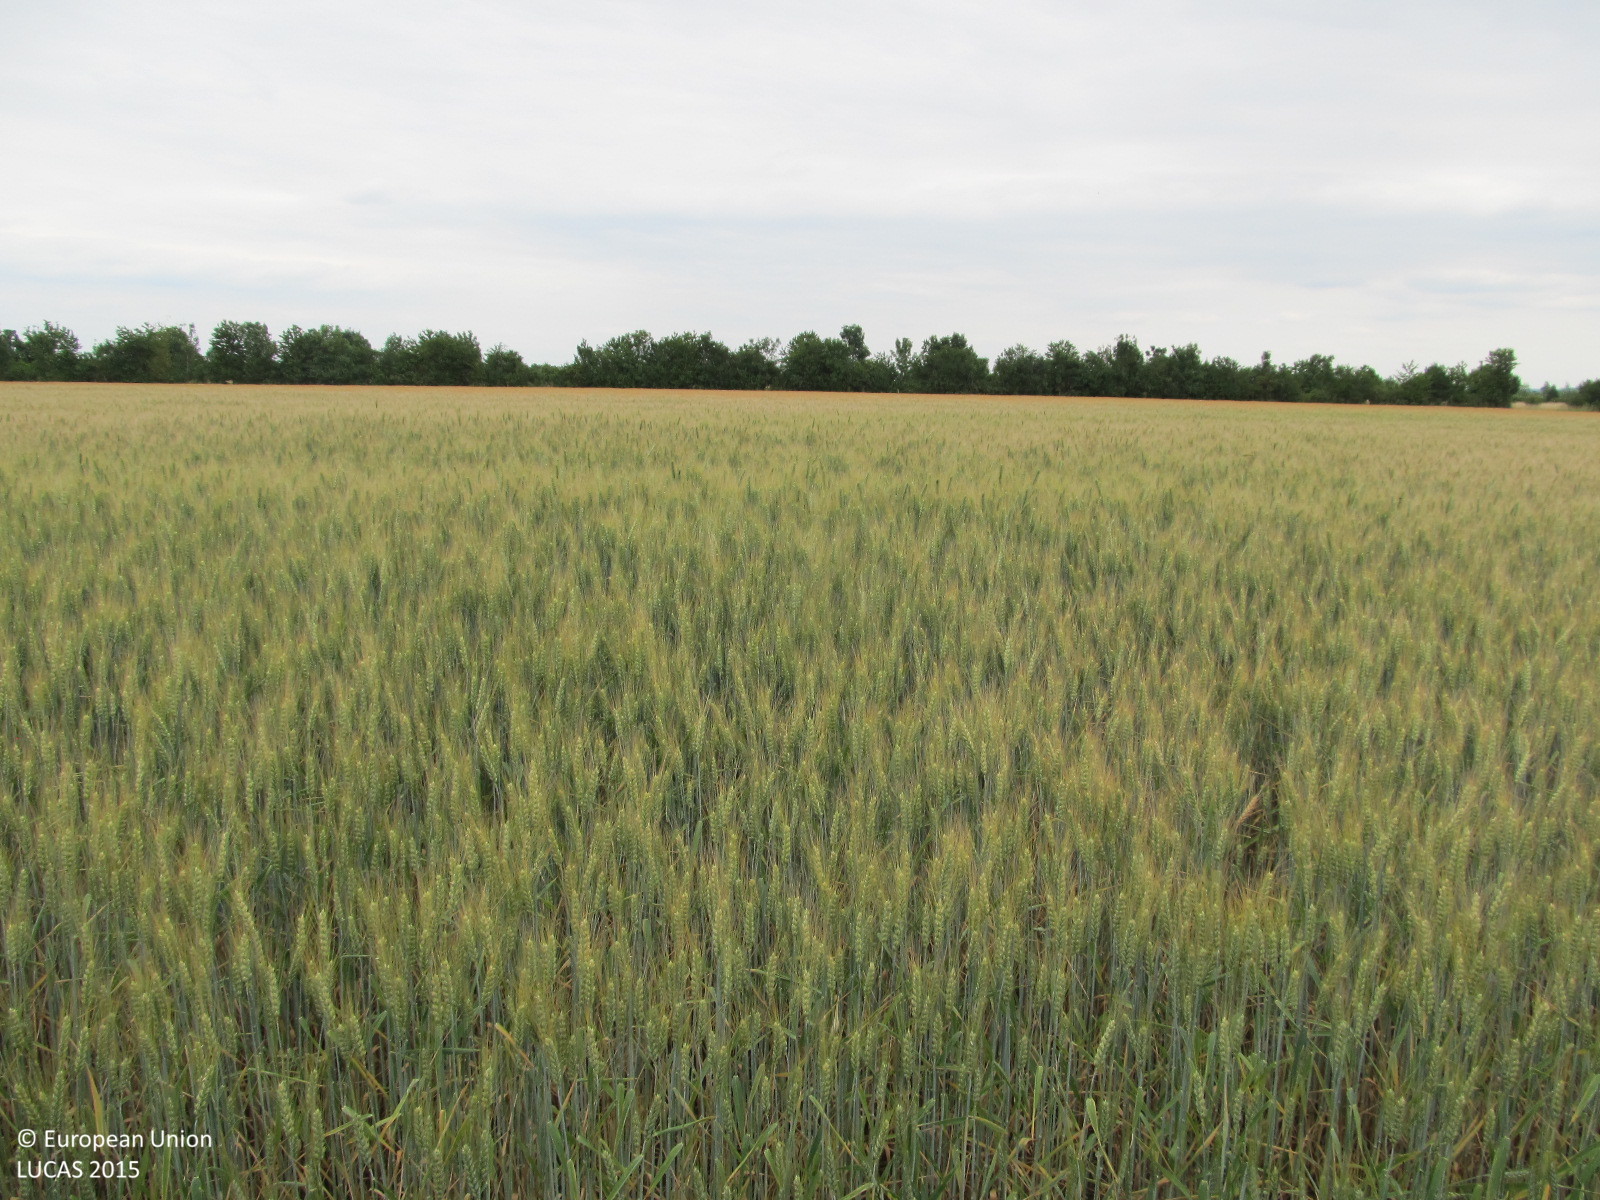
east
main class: Cropland
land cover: Maize
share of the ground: 50 - 75 %
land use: Agriculture (excluding fallow land and kitchen gardens)
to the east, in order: Maize; Barley; Shrubland with sparse tree cover; Ditches and canals; Lines of trees; Grass margins; Tracks; Grassland without tree/shrub cover; Spontaneously vegetated surfaces
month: June
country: AT
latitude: 48.3391
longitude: 15.8451
